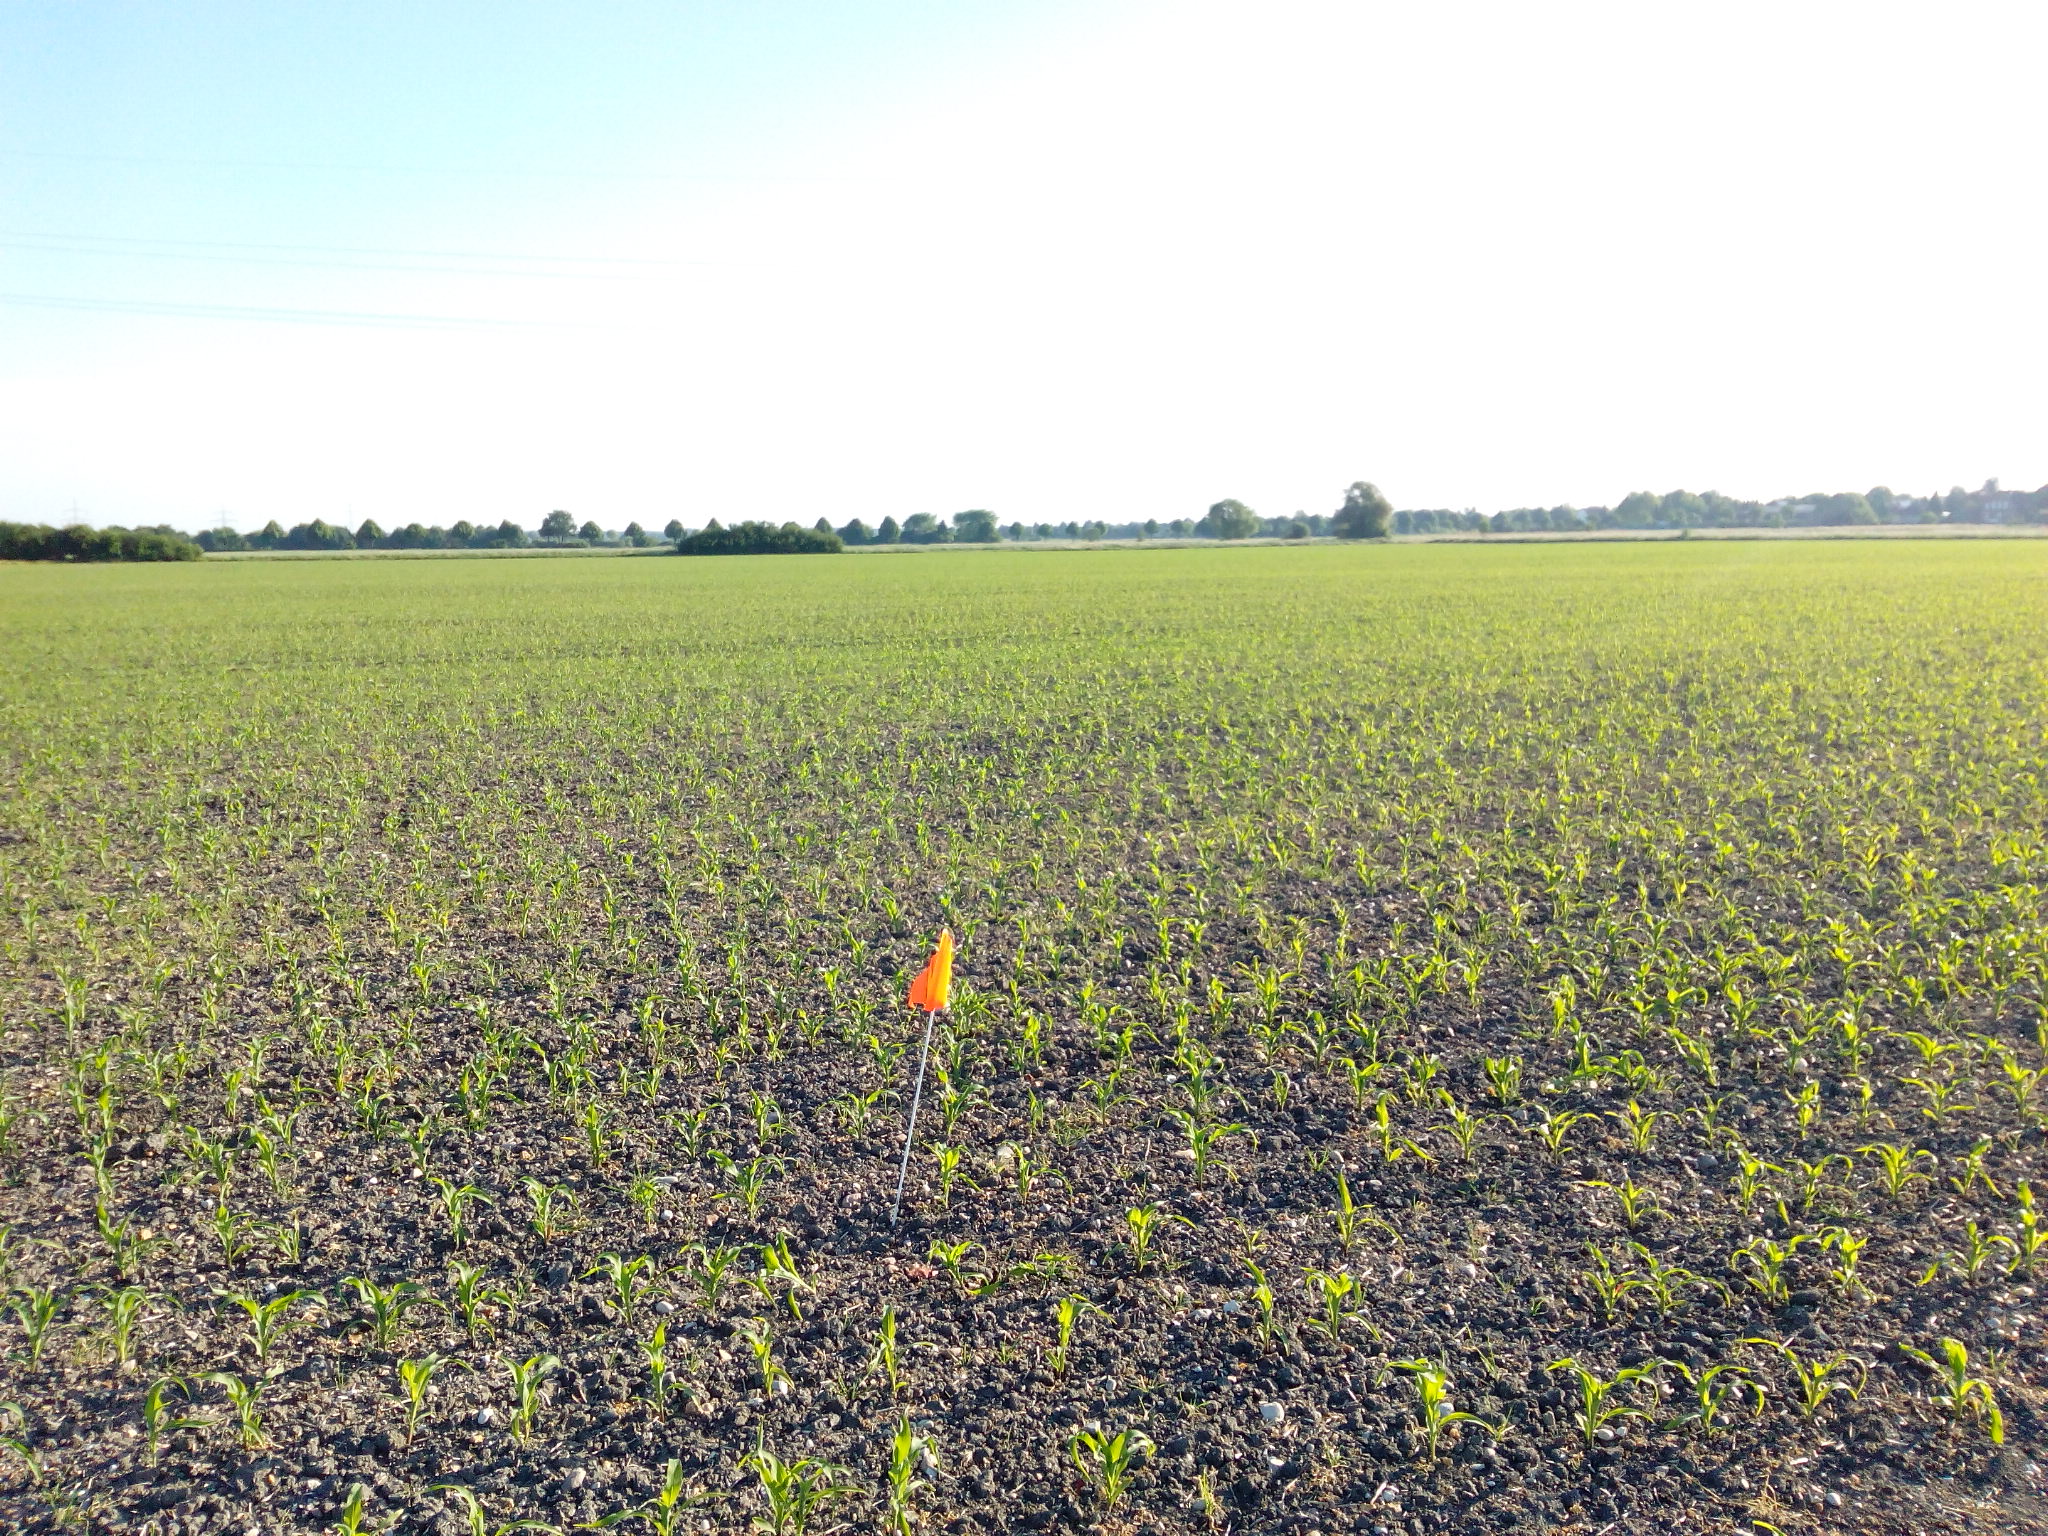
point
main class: Cropland
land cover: Maize
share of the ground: 10 - 25 %
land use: Agriculture (excluding fallow land and kitchen gardens)
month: June
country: DE
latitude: 52.3594
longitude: 9.8973
